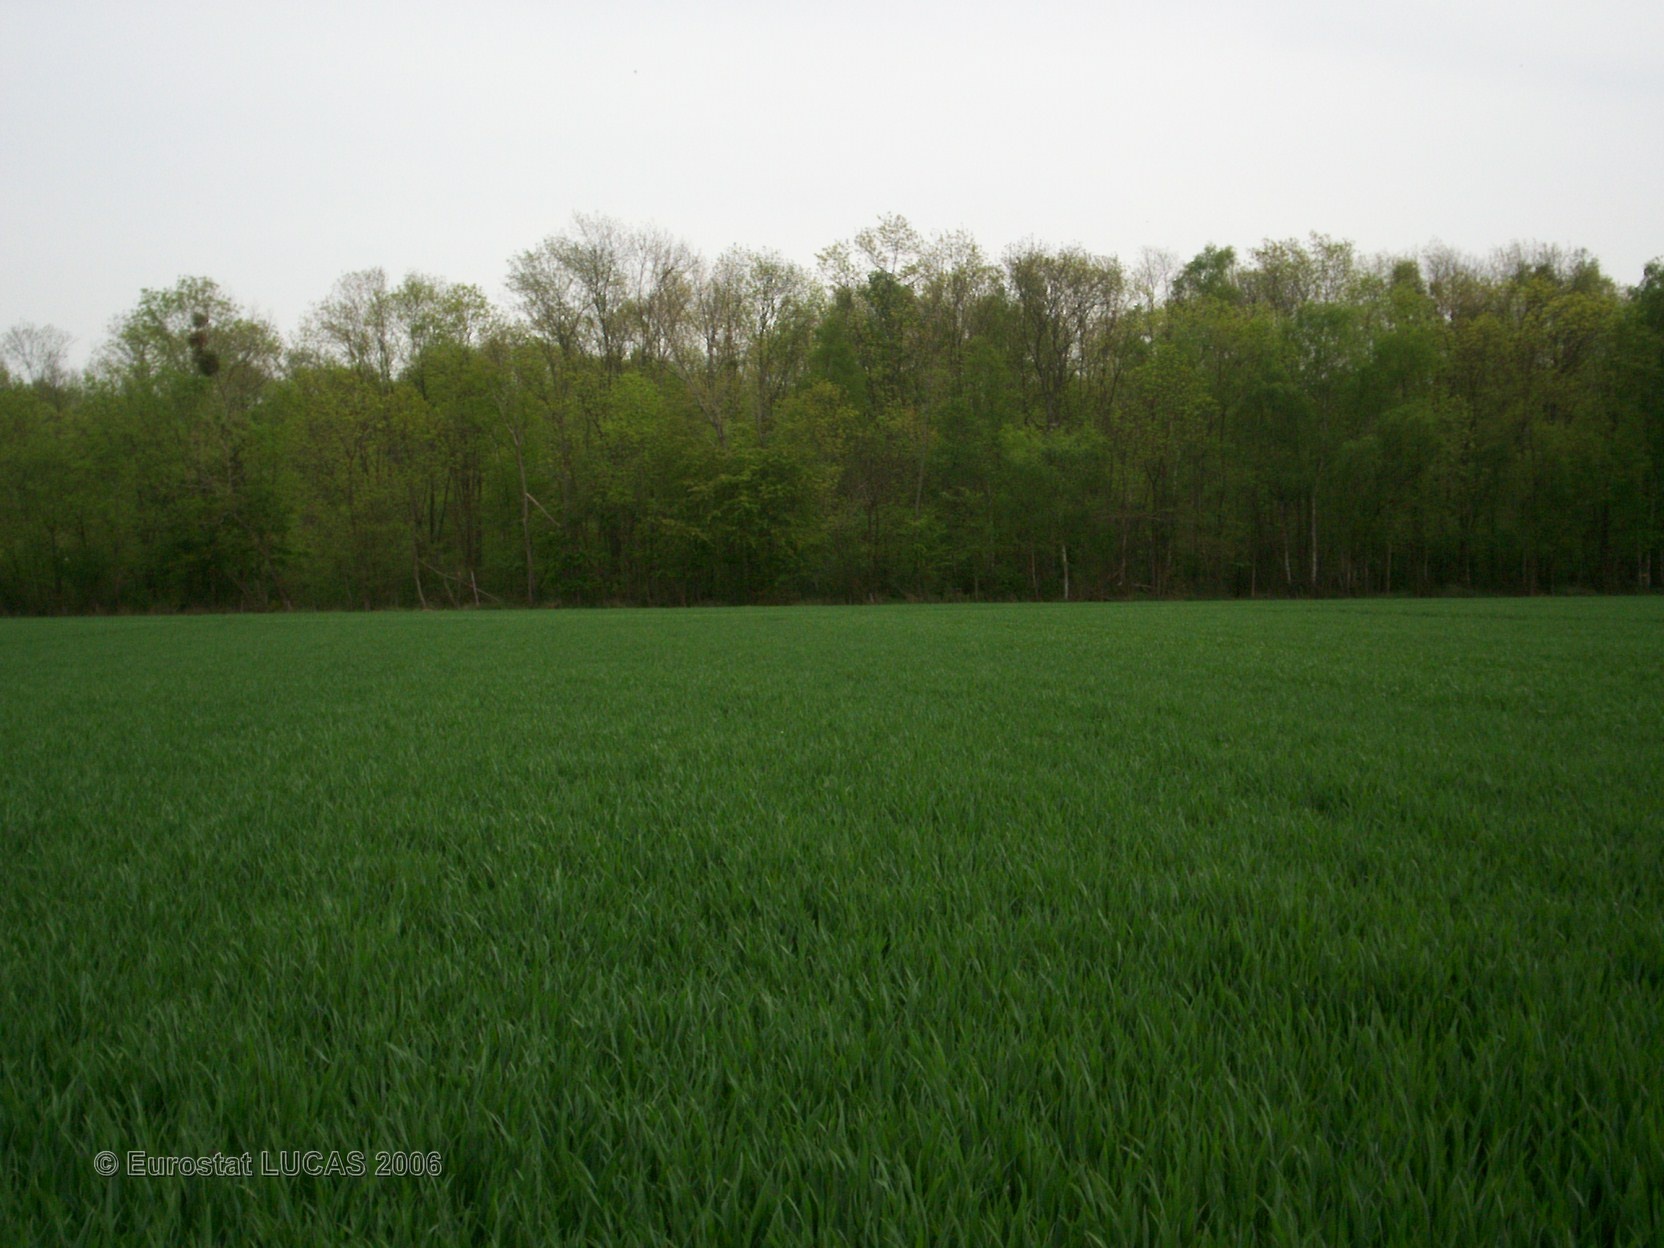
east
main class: Cropland
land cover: Common wheat
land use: Agriculture (excluding fallow land and kitchen gardens)
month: May
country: FR
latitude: 48.6801
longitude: 2.8877
